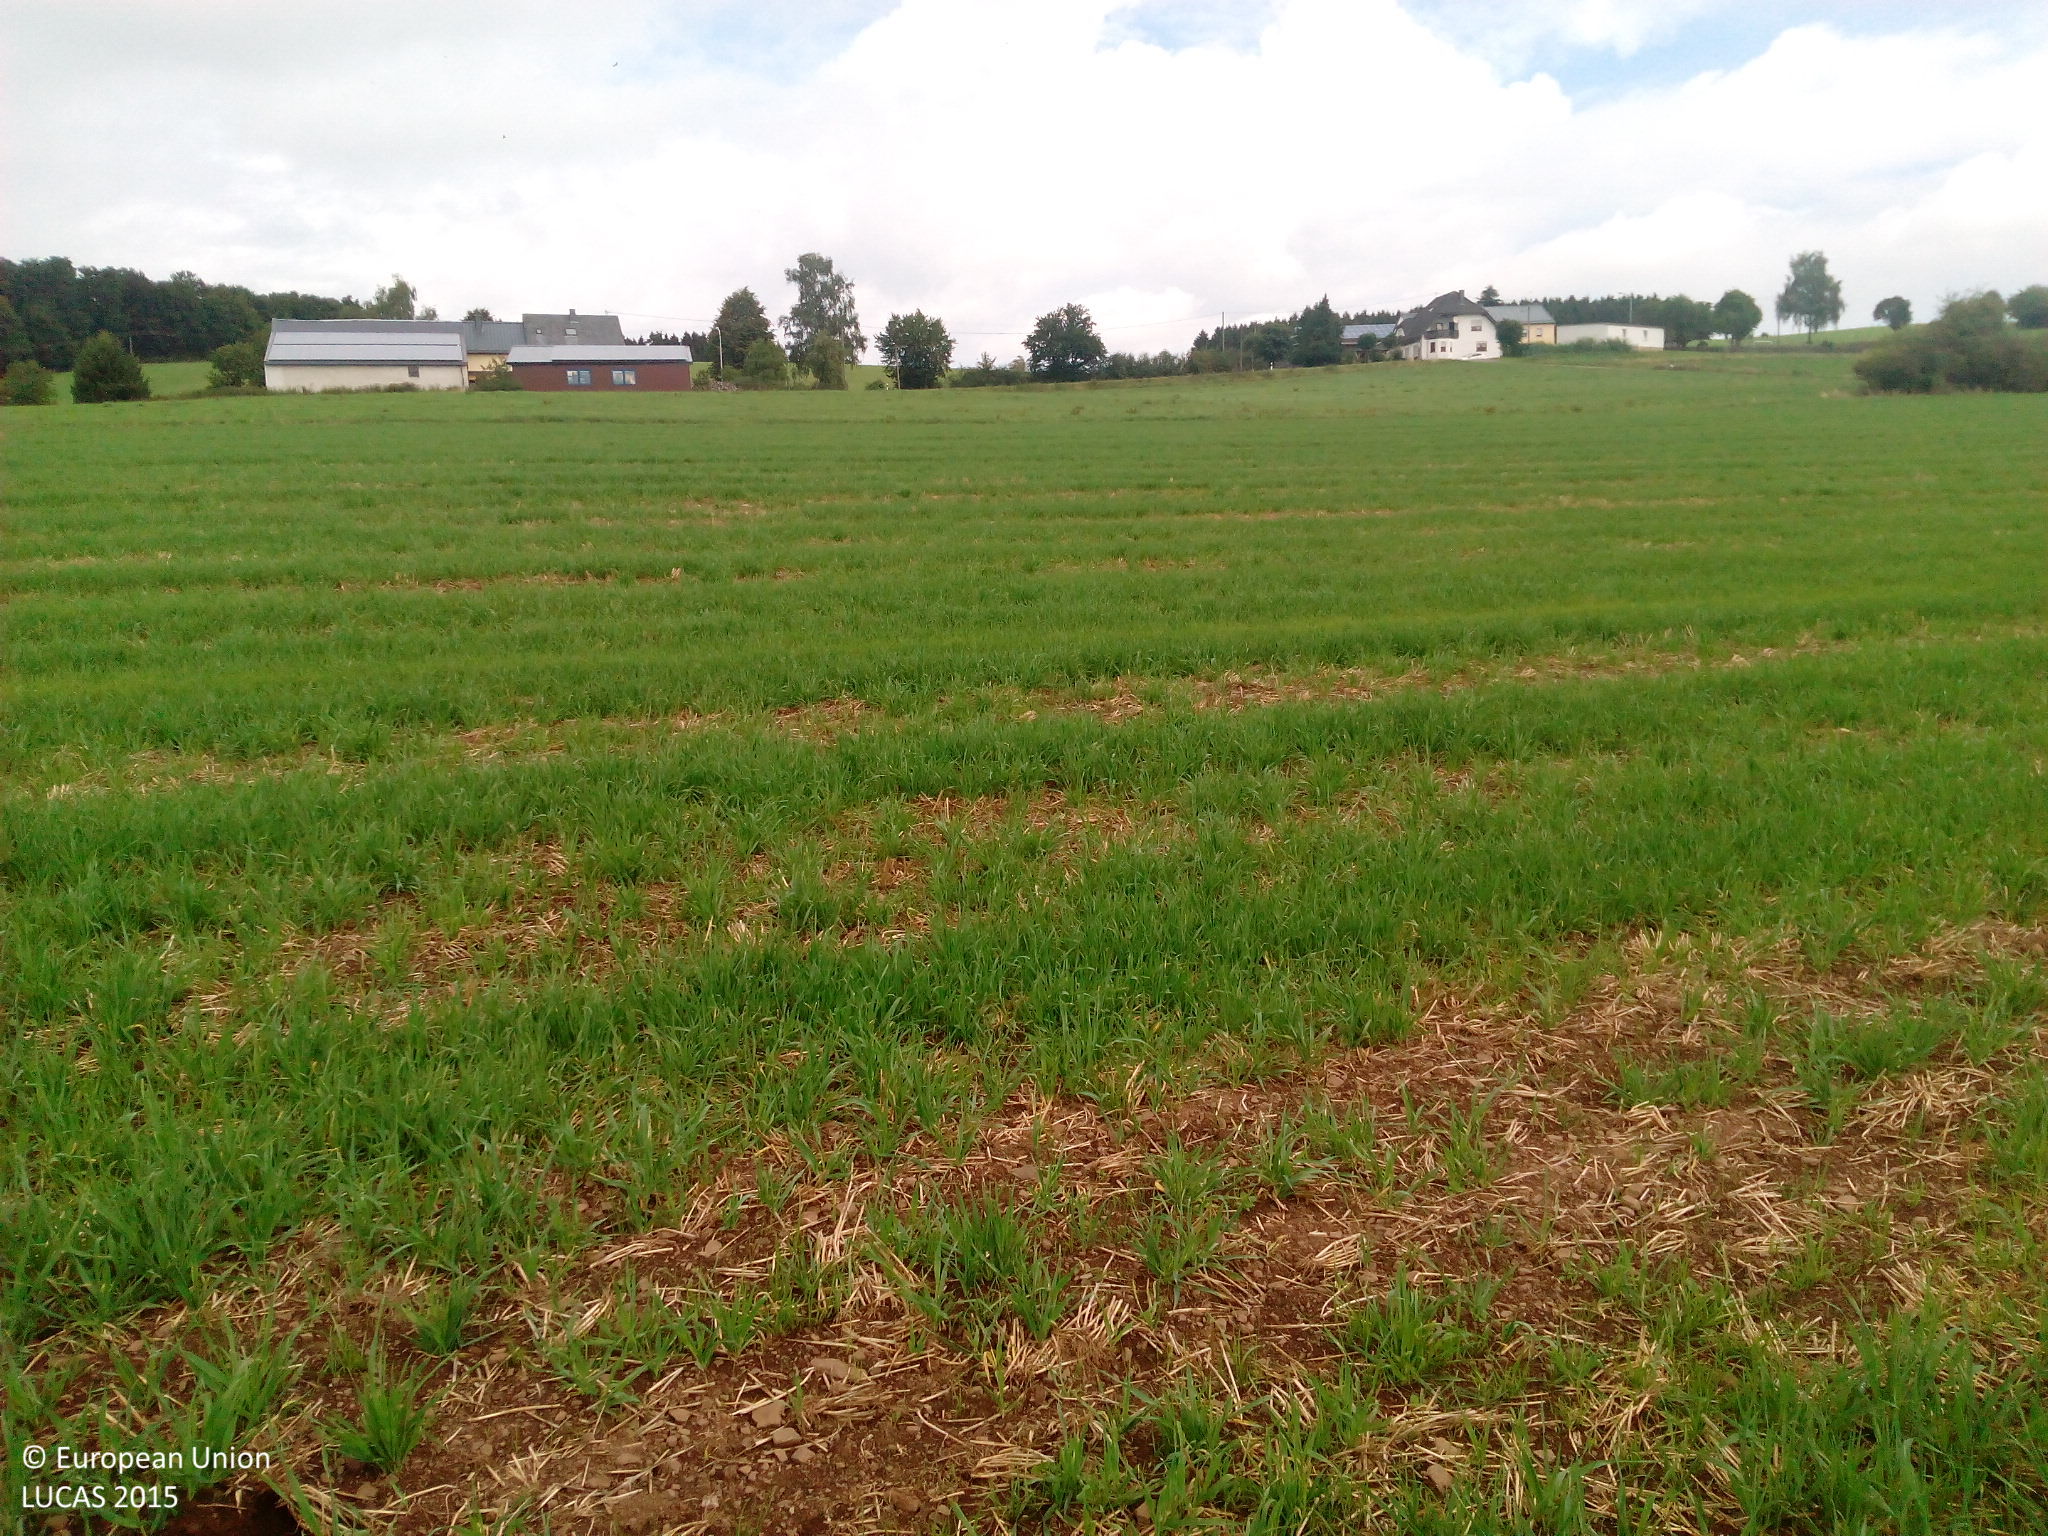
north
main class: Cropland
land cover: Barley
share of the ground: < 10 %
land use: Agriculture (excluding fallow land and kitchen gardens)
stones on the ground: < 10 %
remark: Harvested field
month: August
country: DE
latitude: 50.2138
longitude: 6.2858
